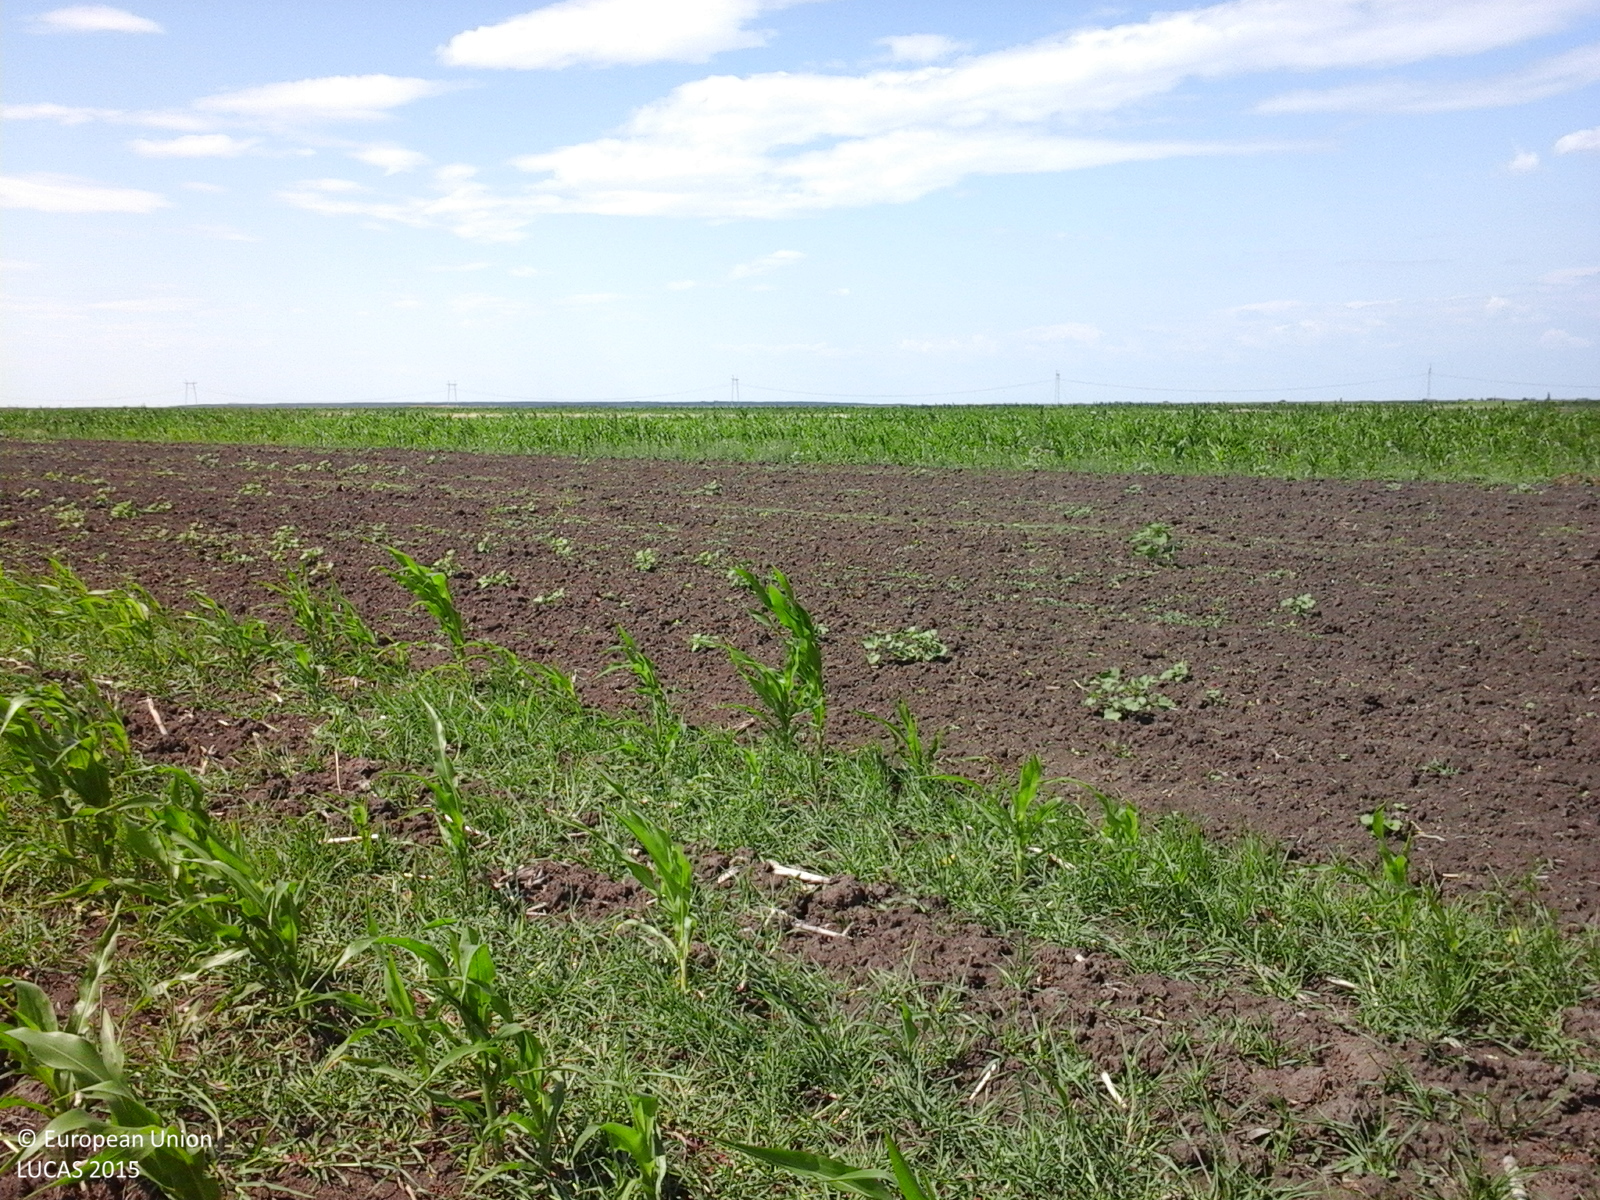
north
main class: Cropland
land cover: Maize
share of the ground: 25 - 50 %
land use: Agriculture (excluding fallow land and kitchen gardens)
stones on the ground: < 10 %
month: July
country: RO
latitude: 44.2406
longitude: 25.5034
